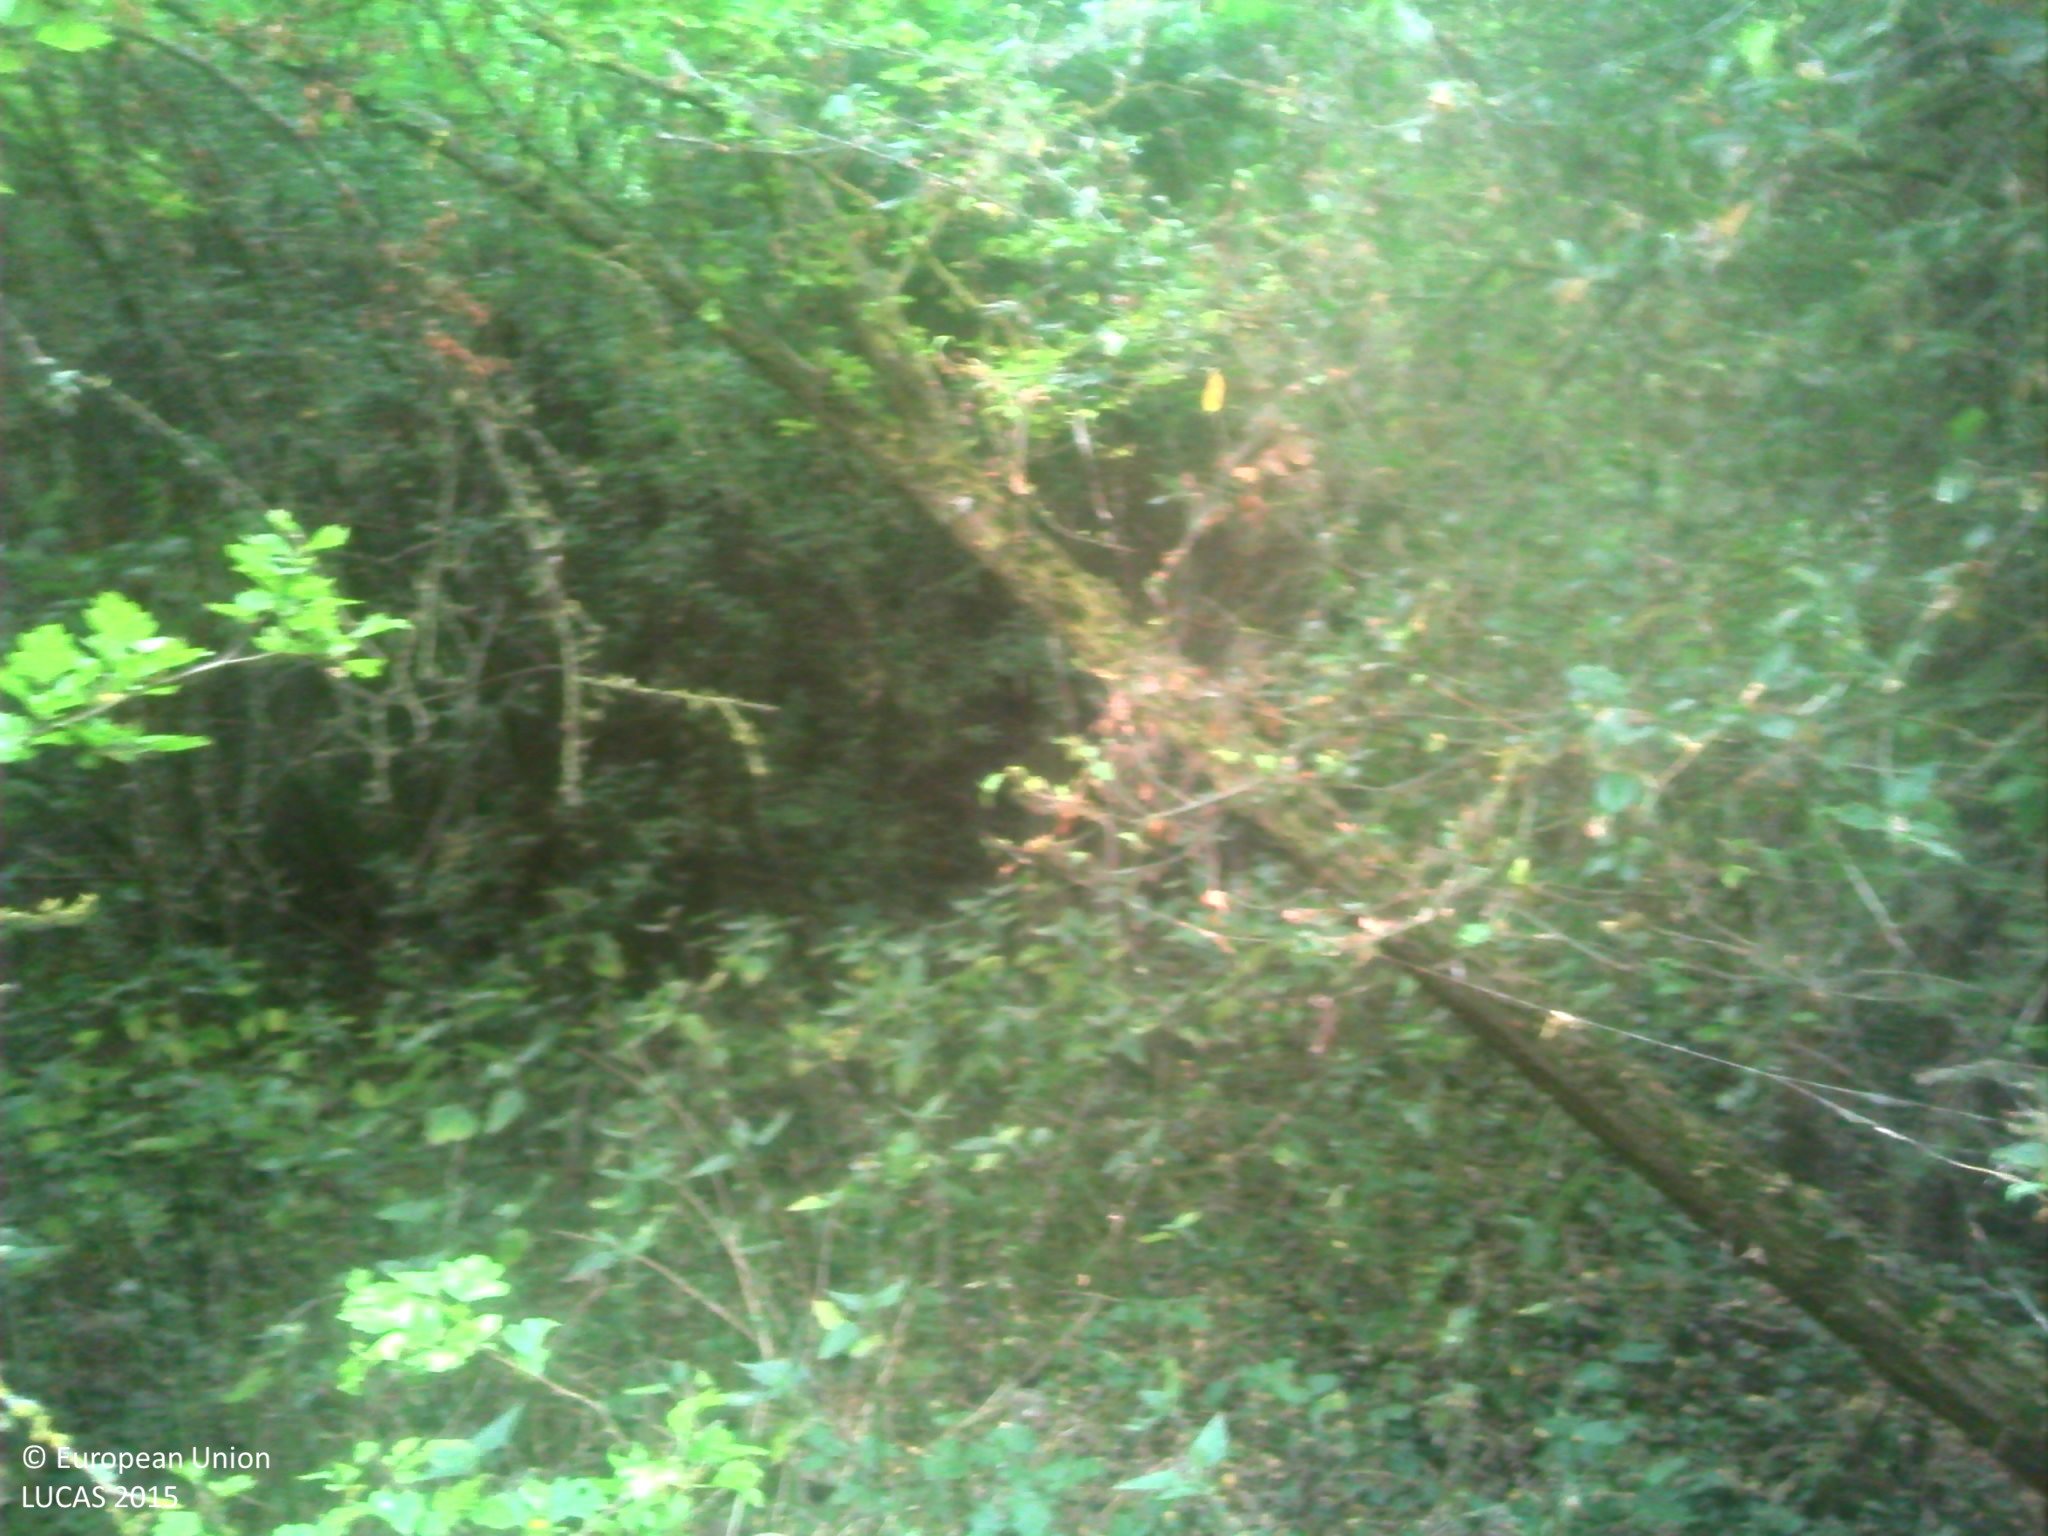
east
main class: Woodland
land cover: Broadleaved woodland
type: mesophytic deciduous forest
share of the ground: > 75 %
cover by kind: broadleaved forest trees 50 %, herbaceous plants 50 %
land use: Semi-natural and natural areas not in use
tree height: > 5 m
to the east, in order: Broadleaved woodland; Rivers and streams; Grassland without tree/shrub cover
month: July
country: FR
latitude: 47.7167
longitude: 1.3062
